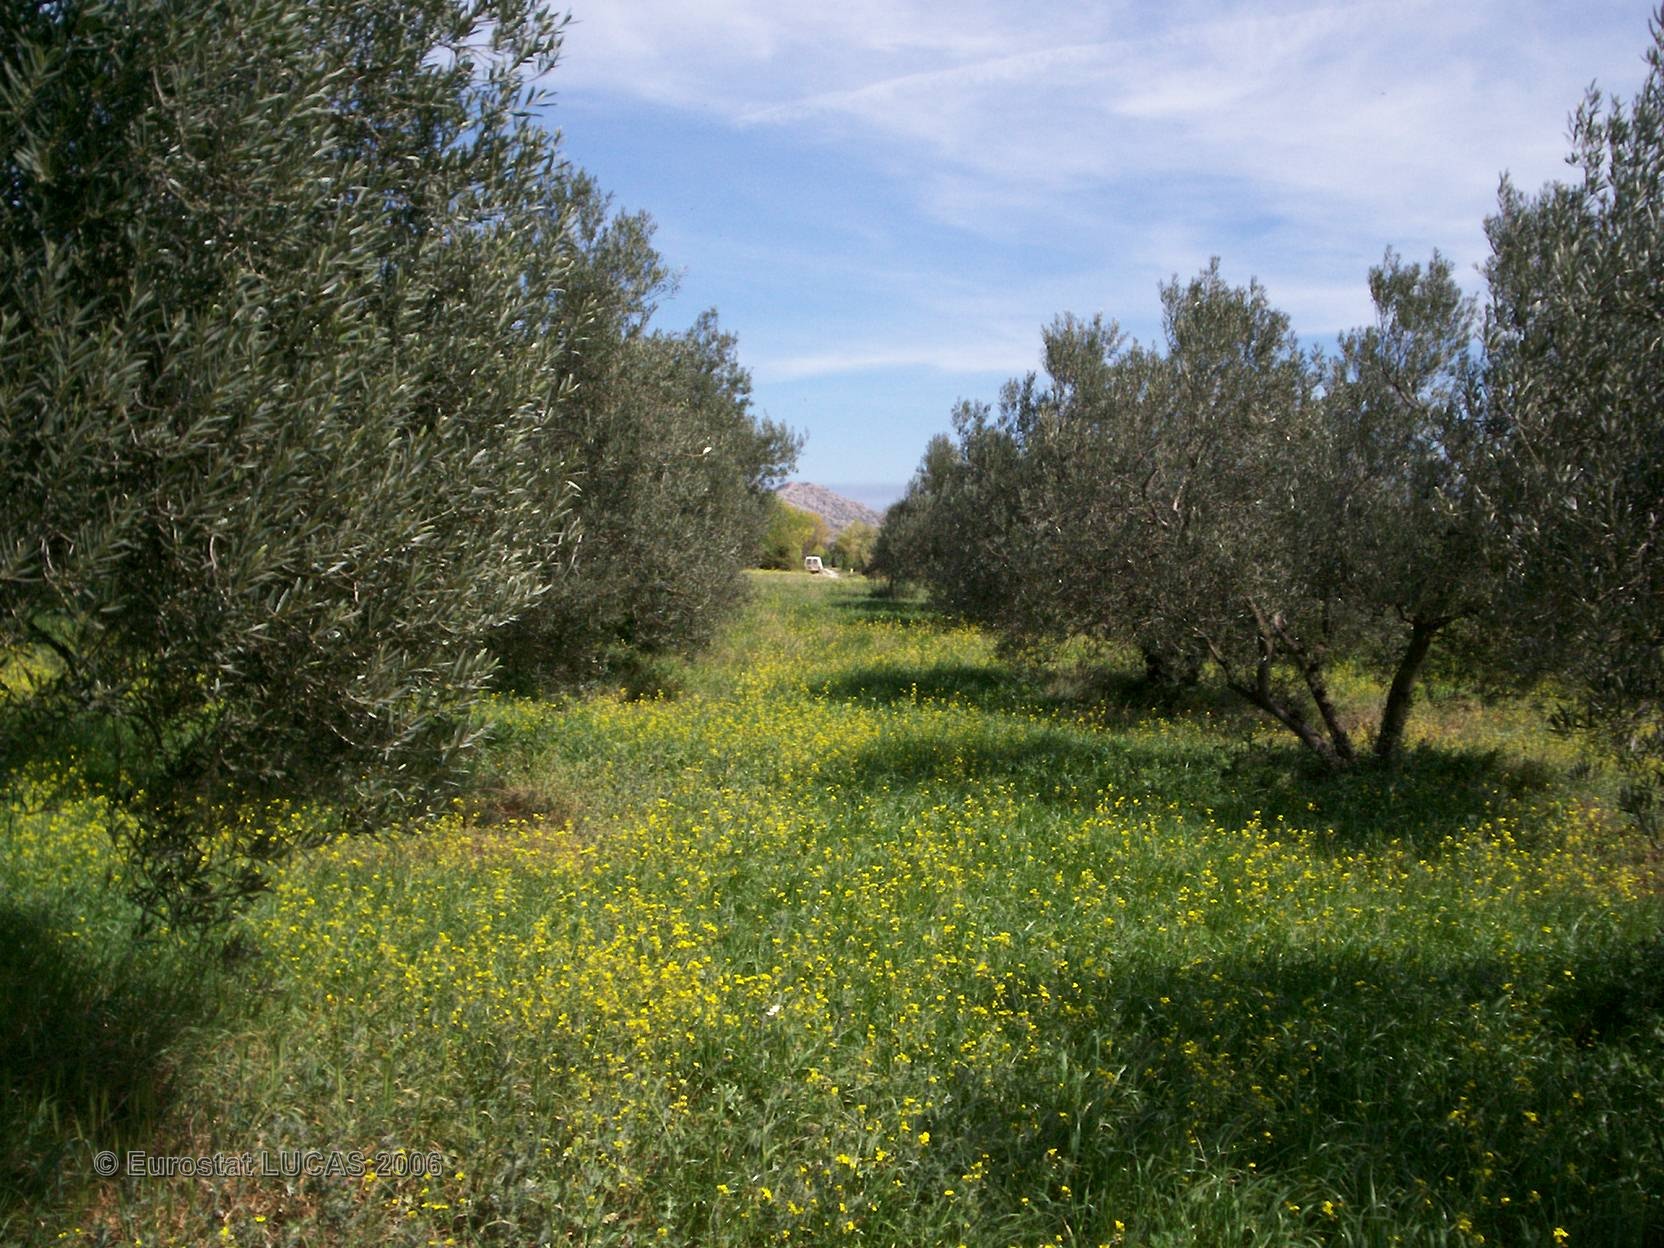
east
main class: Cropland
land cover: Olive groves
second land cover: Grassland with sparse tree/shrub cover
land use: Agriculture (excluding fallow land and kitchen gardens)
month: April
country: FR
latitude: 43.7027
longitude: 4.9340
